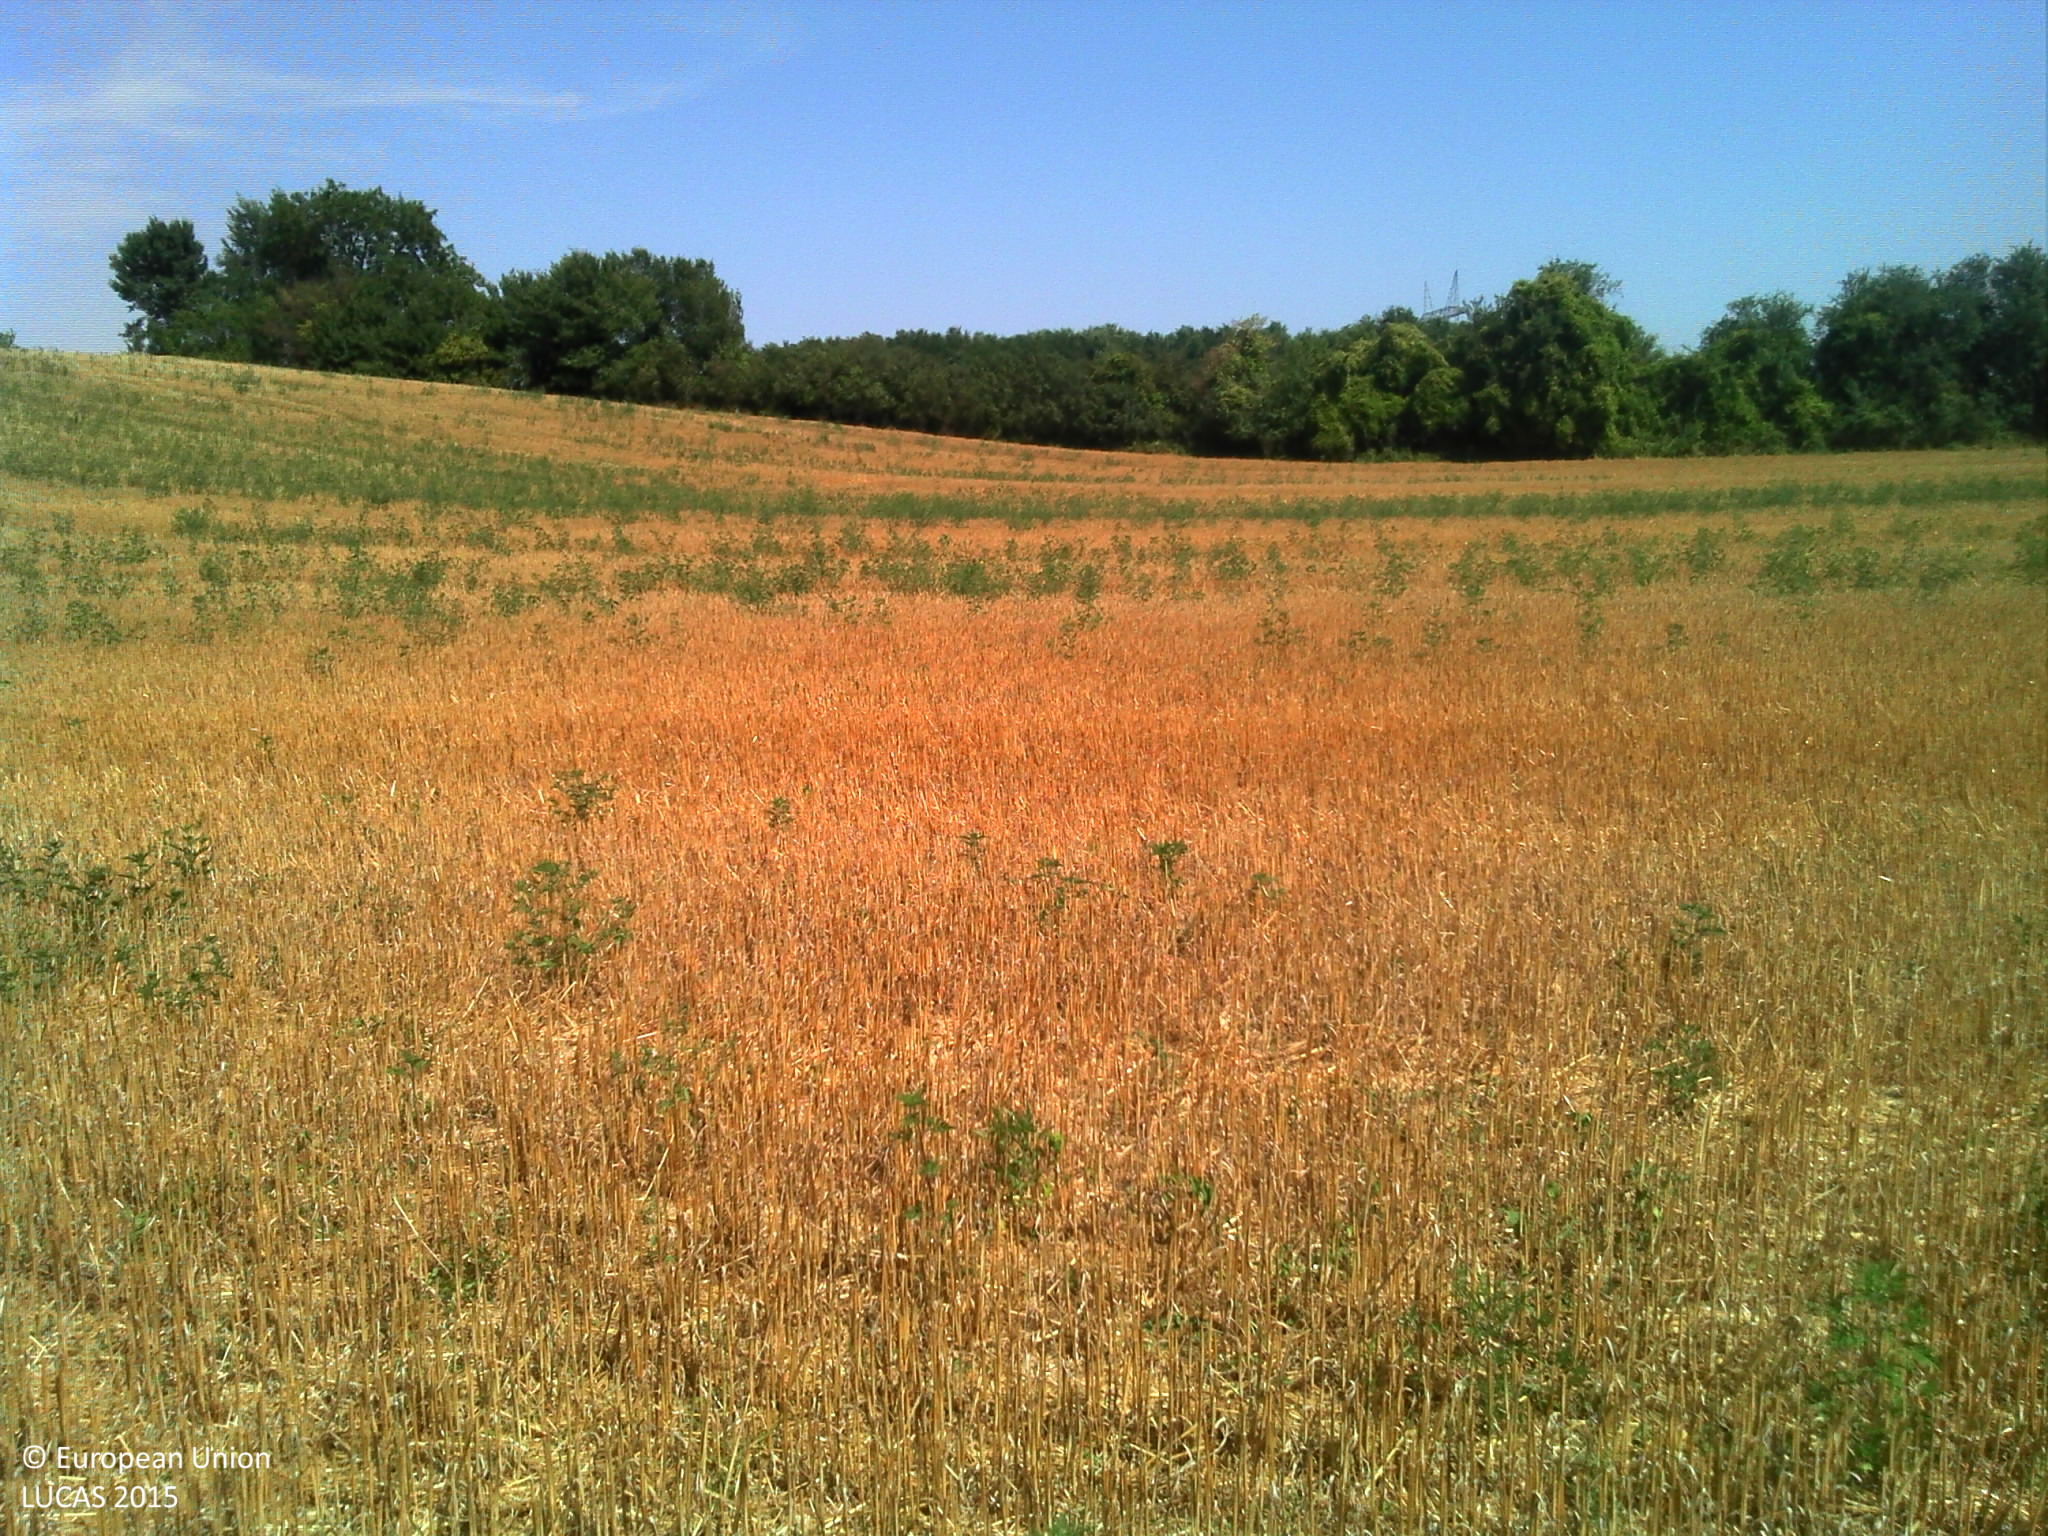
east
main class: Cropland
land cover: Durum wheat
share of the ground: > 75 %
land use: Agriculture (excluding fallow land and kitchen gardens)
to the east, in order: Durum wheat; Abandoned hedges; Grassland without tree/shrub cover; Shrubland without tree cover; Grass margins; Paved roads, cycling and walking lanes; Grass margins; Durum wheat
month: August
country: FR
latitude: 45.6369
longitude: 4.9623
